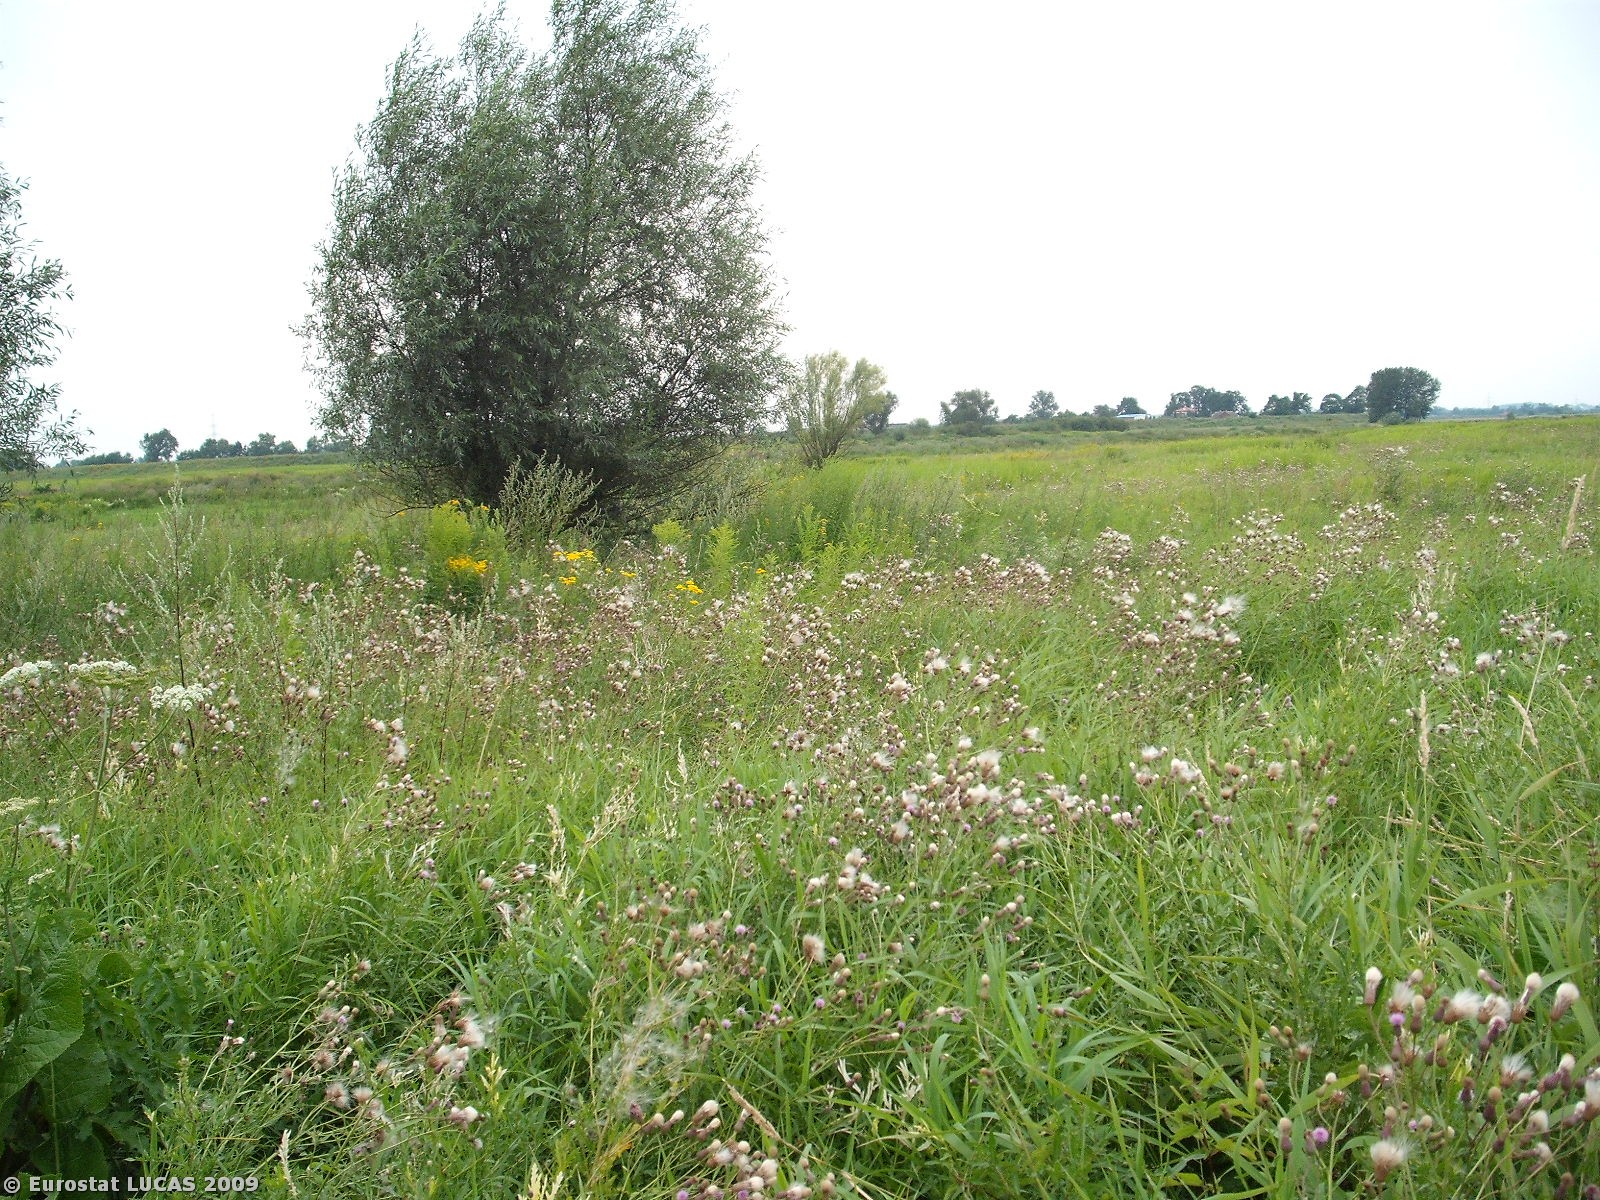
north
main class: Grassland
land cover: Grassland without tree/shrub cover
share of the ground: > 75 %
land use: Unused
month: July
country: PL
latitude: 50.0505
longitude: 20.2155
